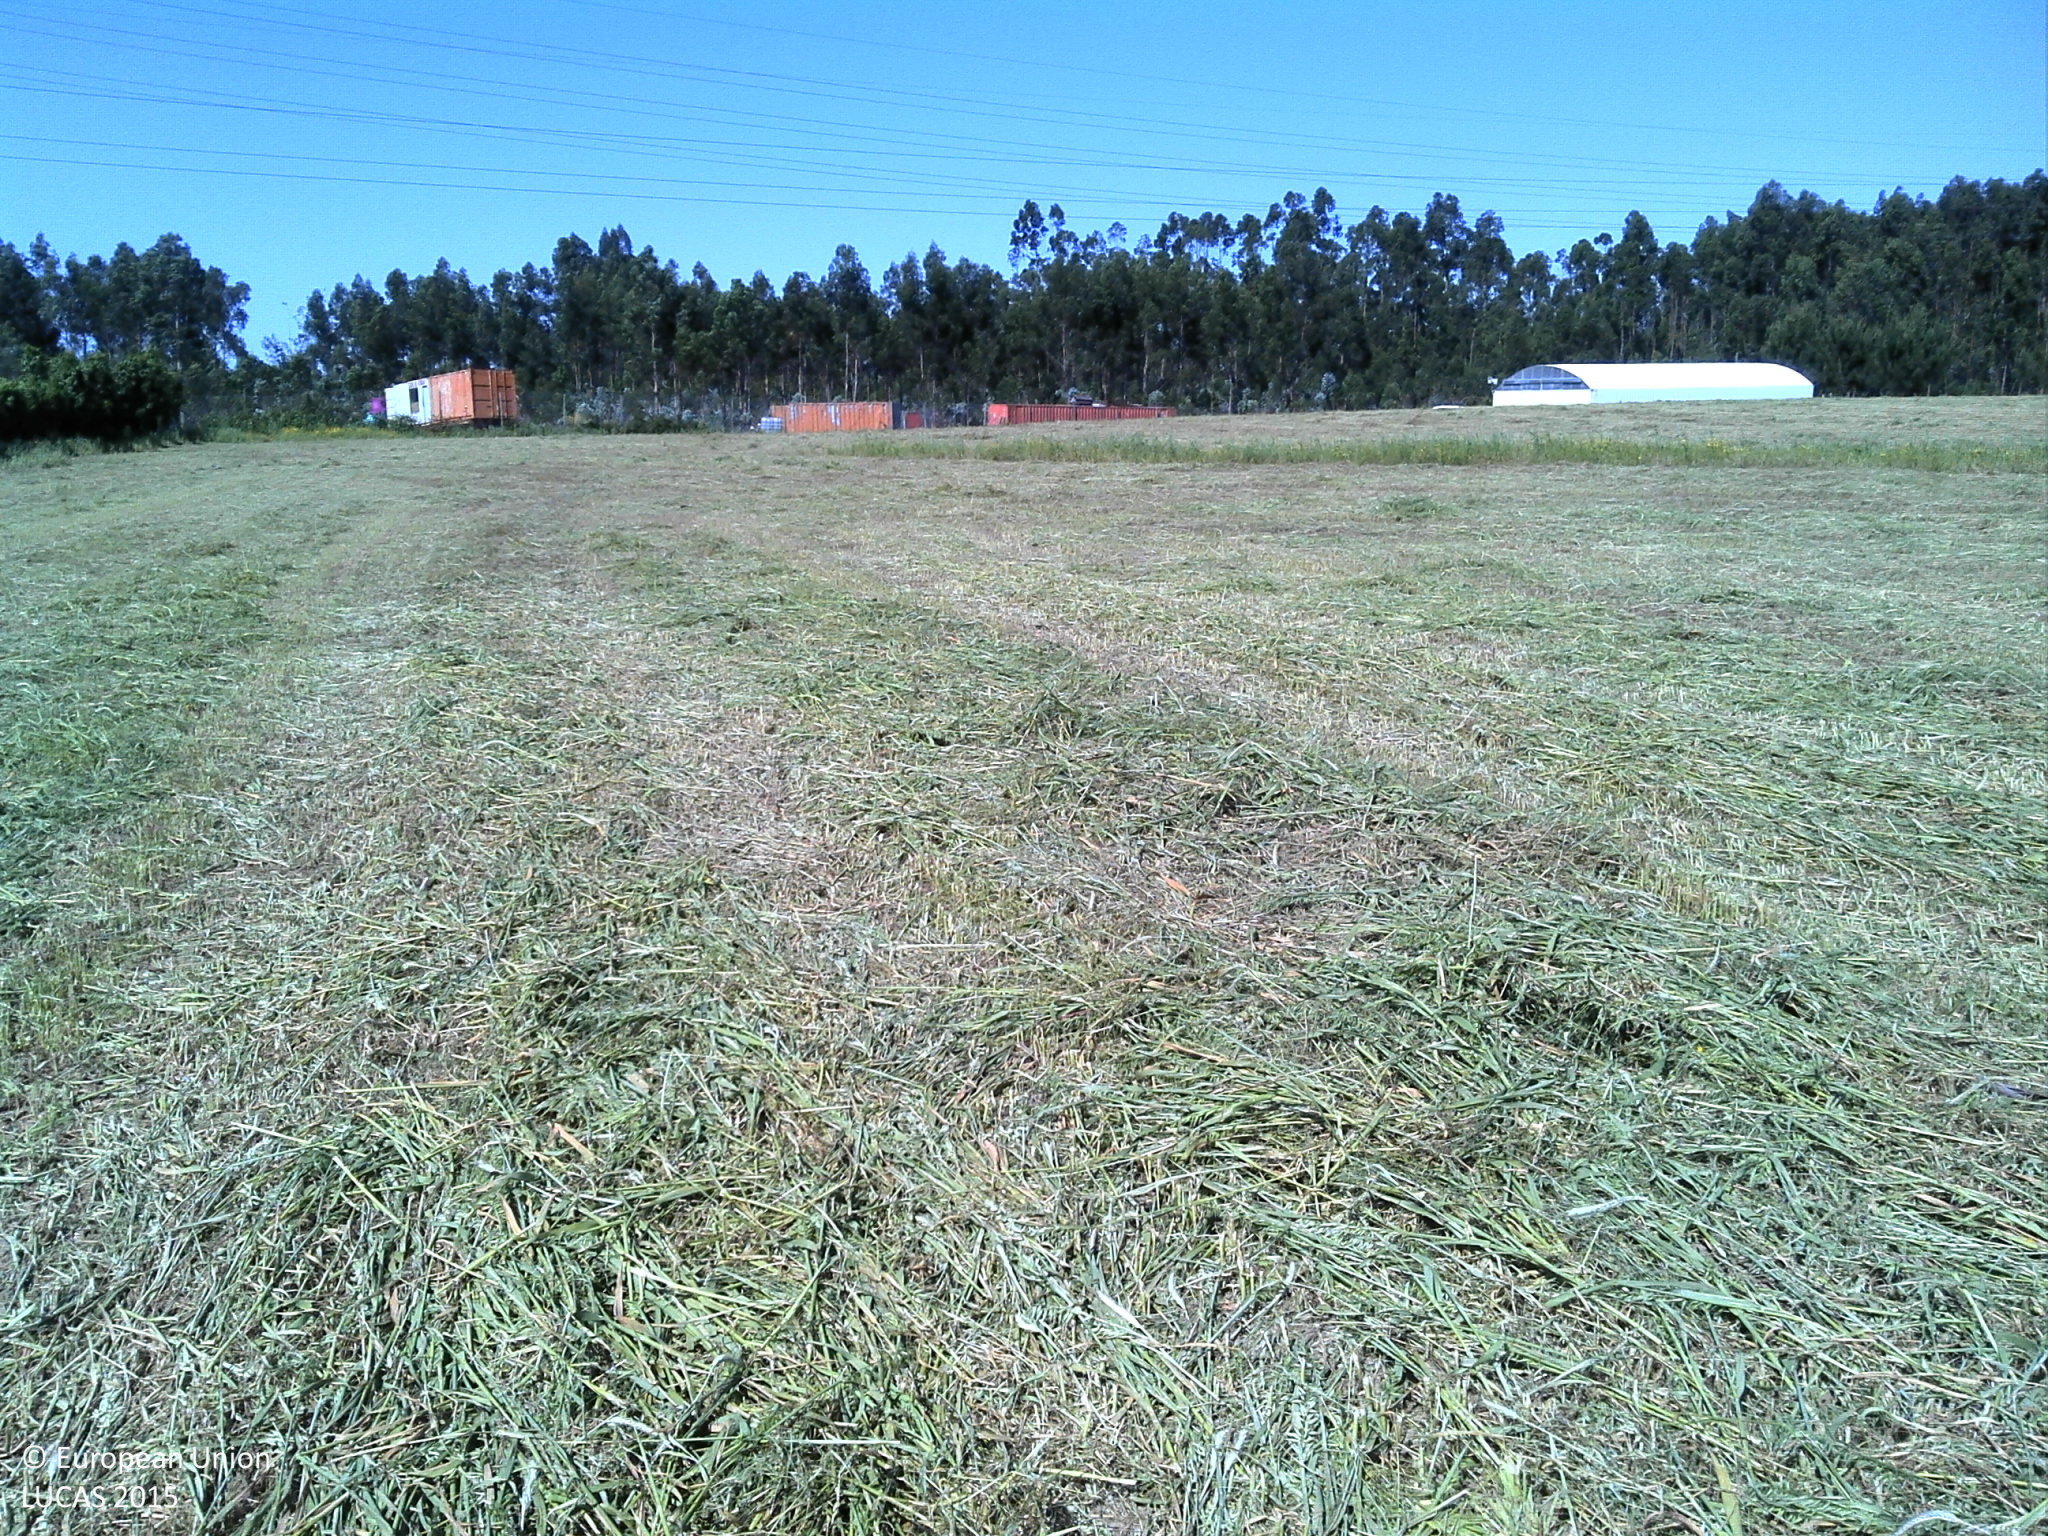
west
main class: Cropland
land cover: Mixed cereals for fodder
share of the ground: 10 - 25 %
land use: Agriculture (excluding fallow land and kitchen gardens)
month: May
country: PT
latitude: 41.2912
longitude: -8.6532
